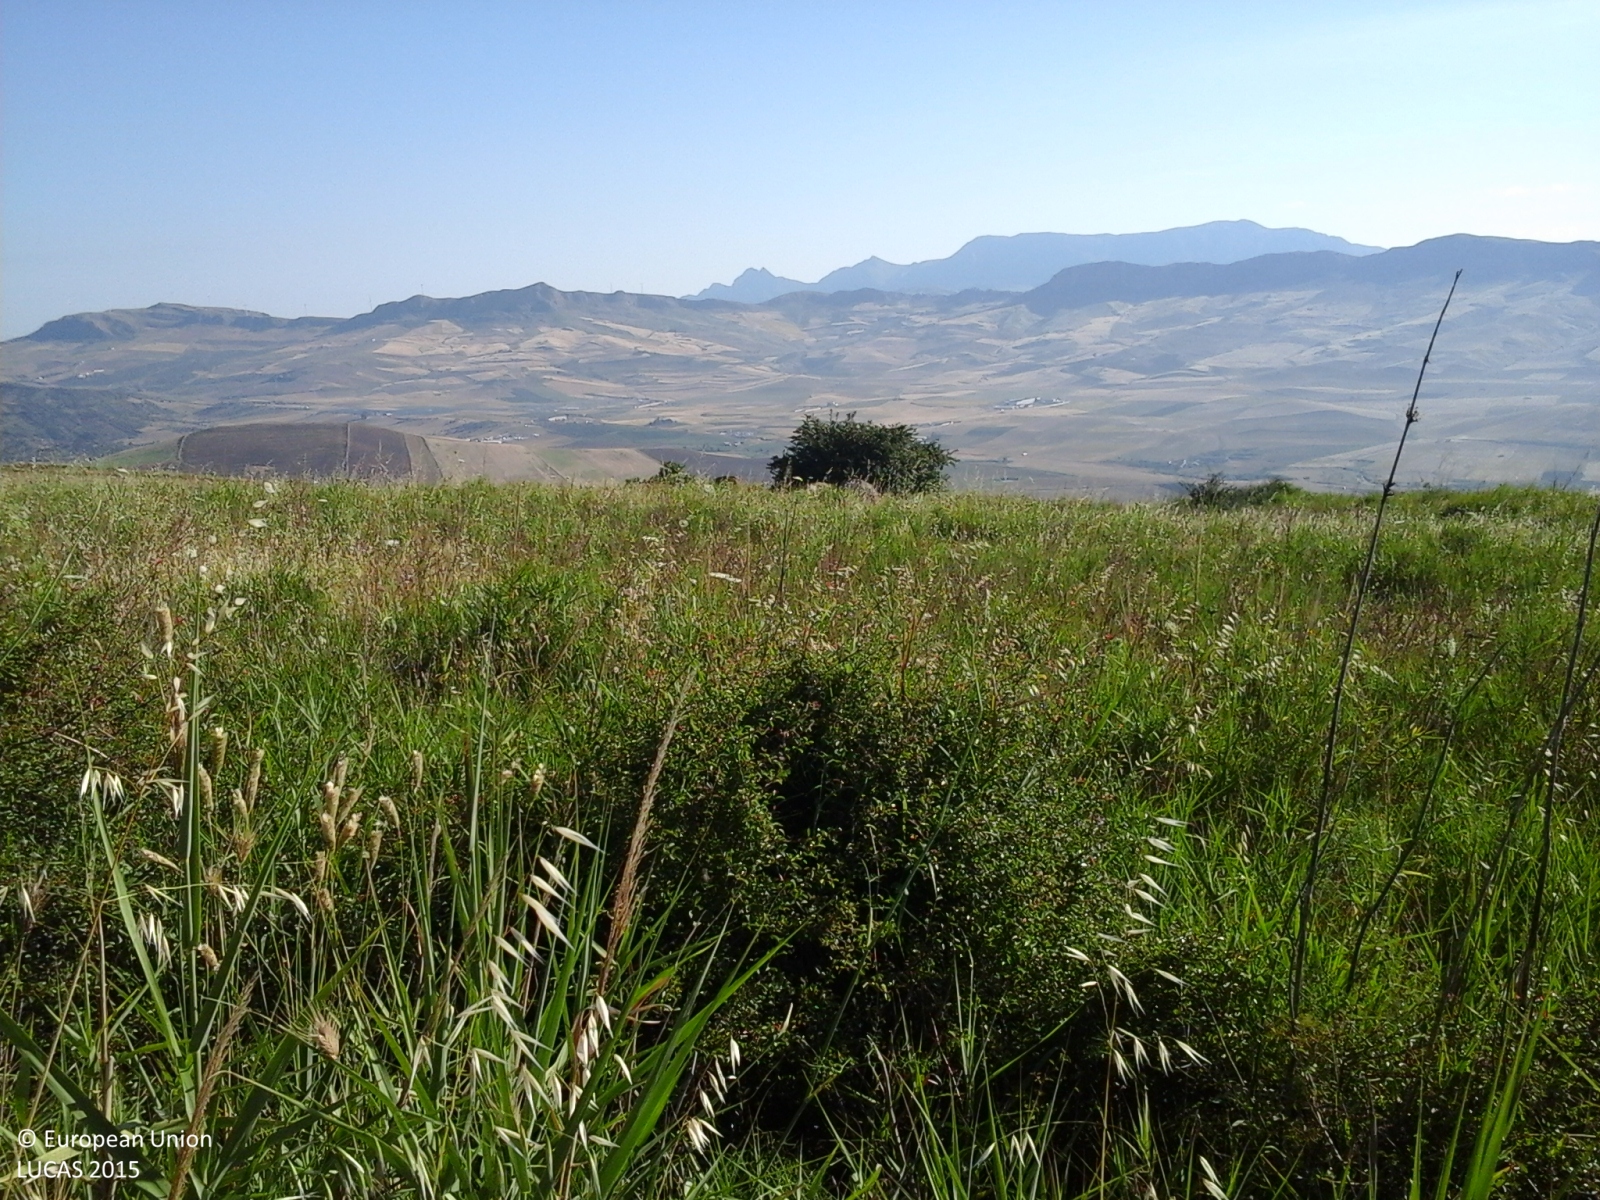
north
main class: Grassland
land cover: Grassland with sparse tree/shrub cover
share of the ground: > 75 %
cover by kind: herbaceous plants 85 %, shrubs 10 %, broadleaved forest trees 5 %
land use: Agriculture (excluding fallow land and kitchen gardens)
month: June
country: IT
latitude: 37.8282
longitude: 13.5080
